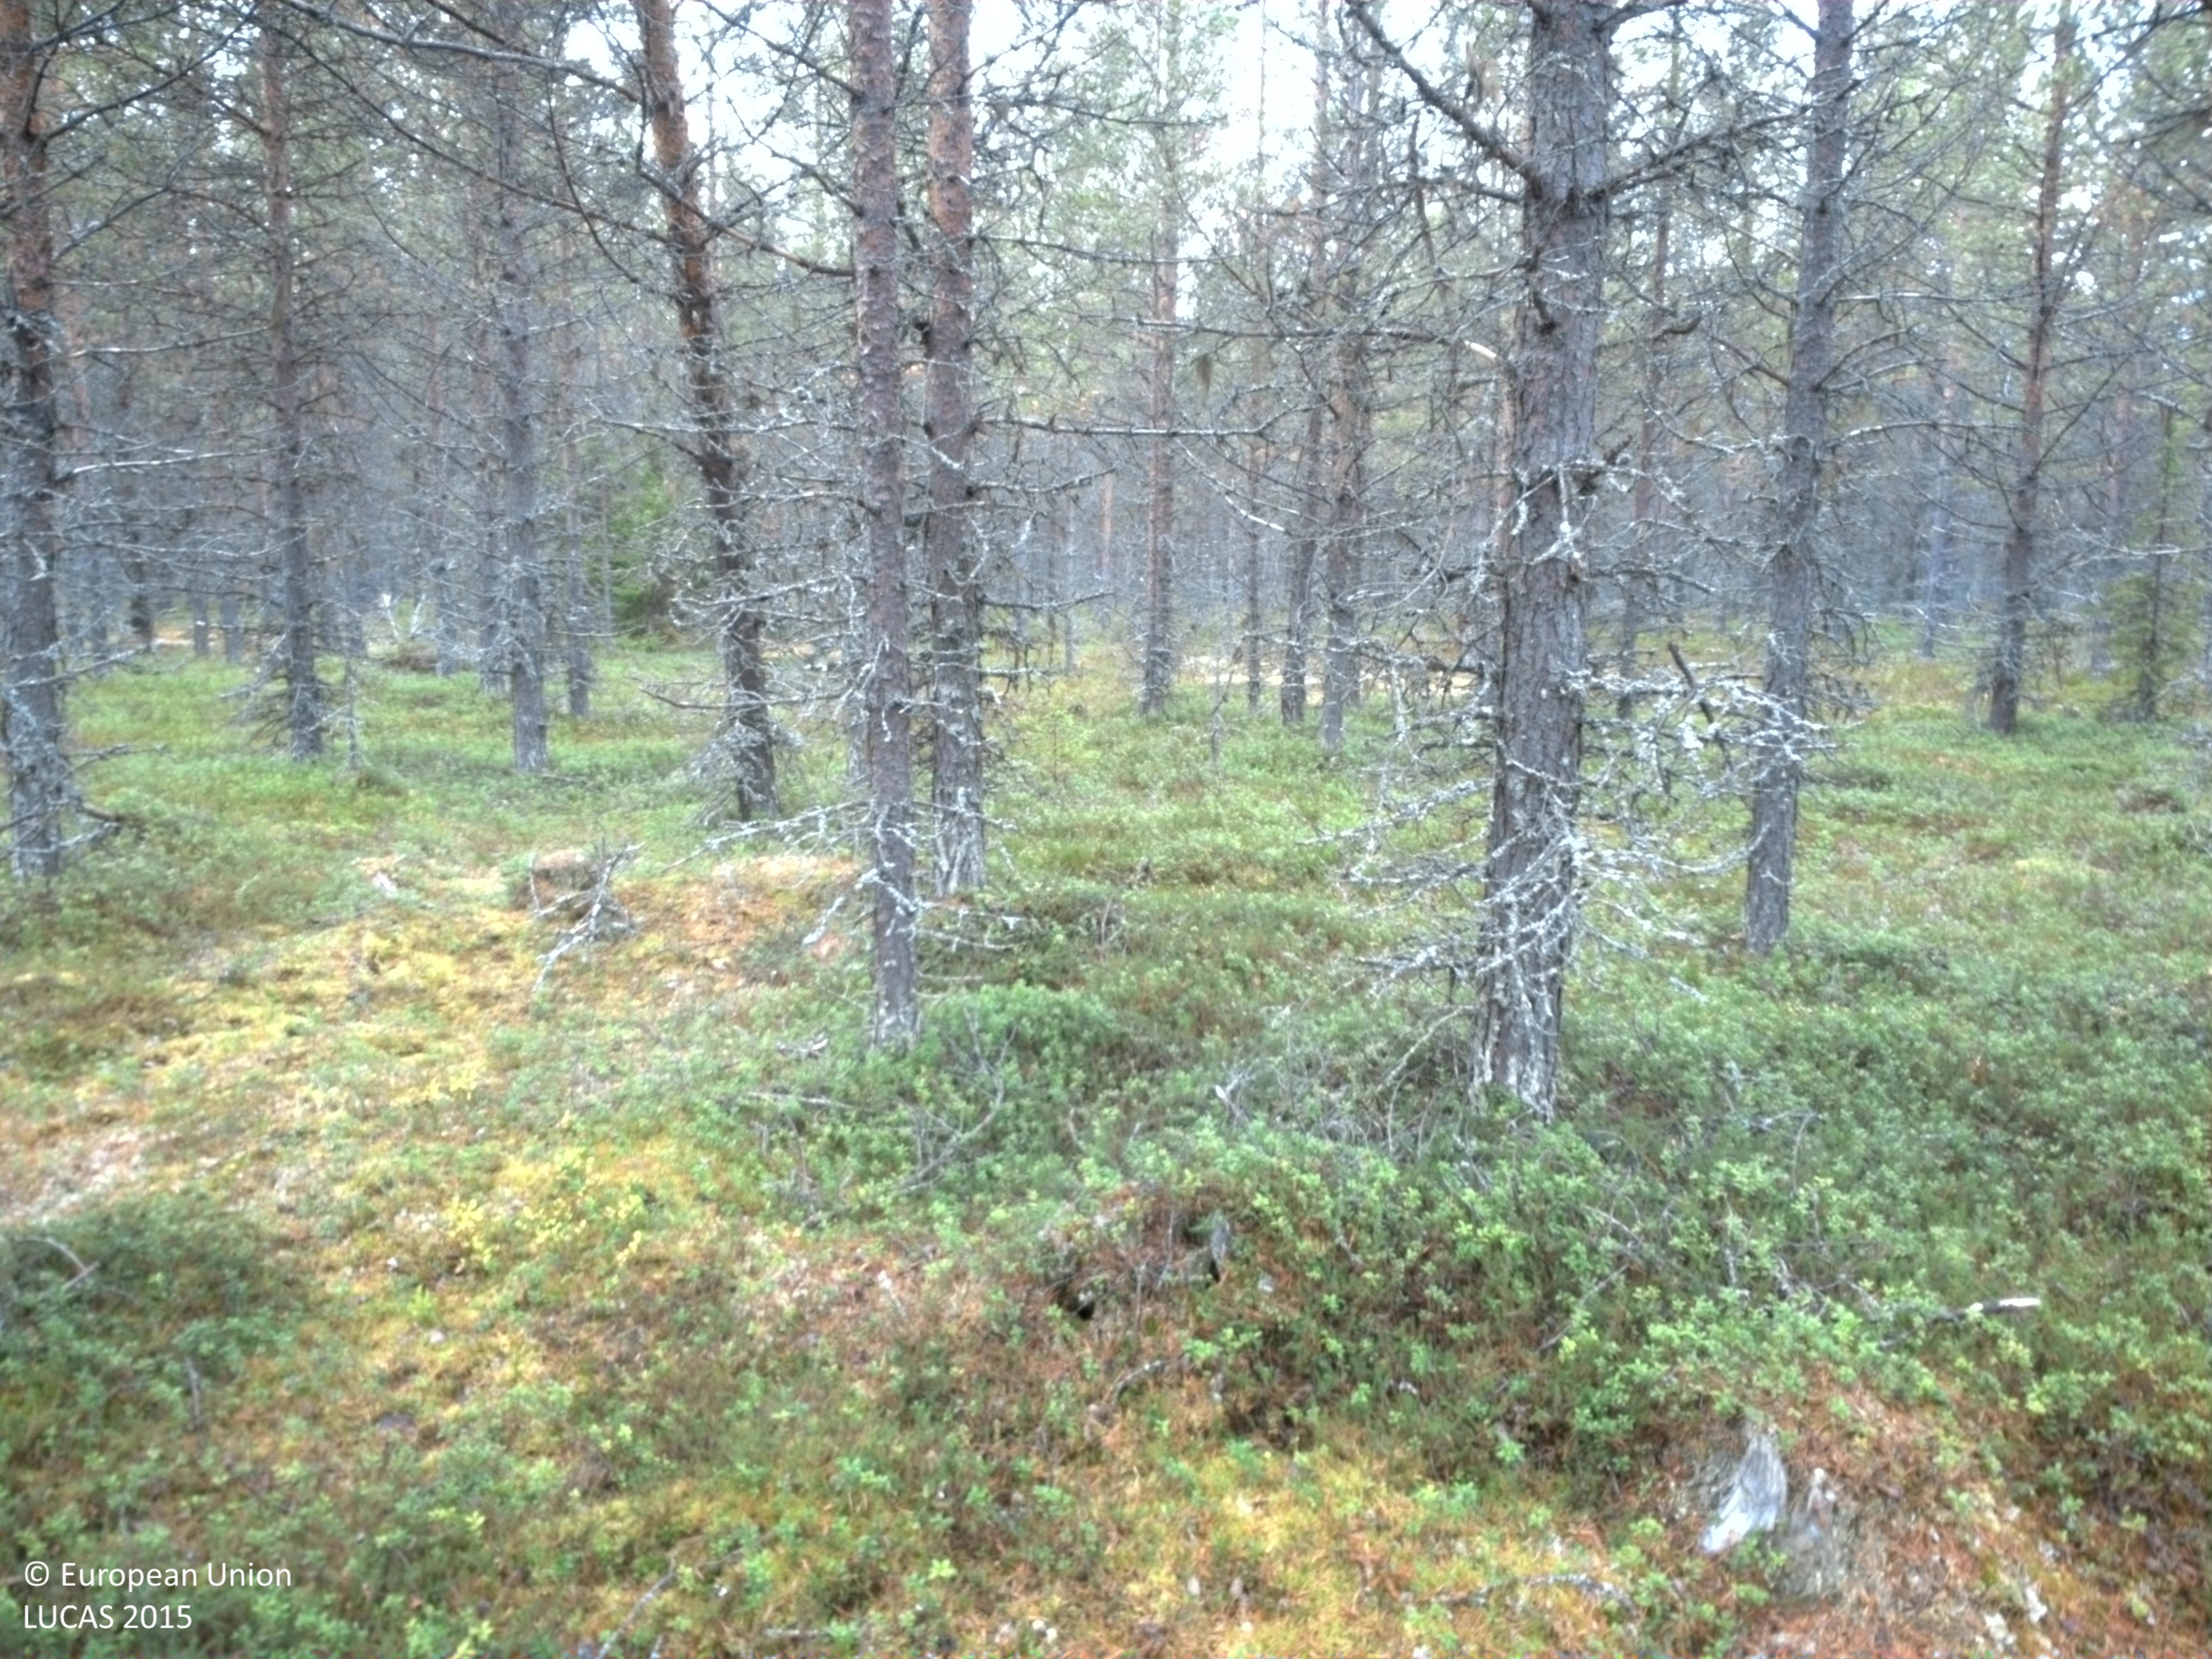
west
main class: Woodland
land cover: Pine dominated coniferous woodland
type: boreal forest
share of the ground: 25 - 50 %
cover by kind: coniferous forest trees 40 %, shrubs 40 %, lichens and mosses 20 %
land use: Forestry
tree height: > 5 m
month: October
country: SE
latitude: 64.6670
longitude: 16.8577
